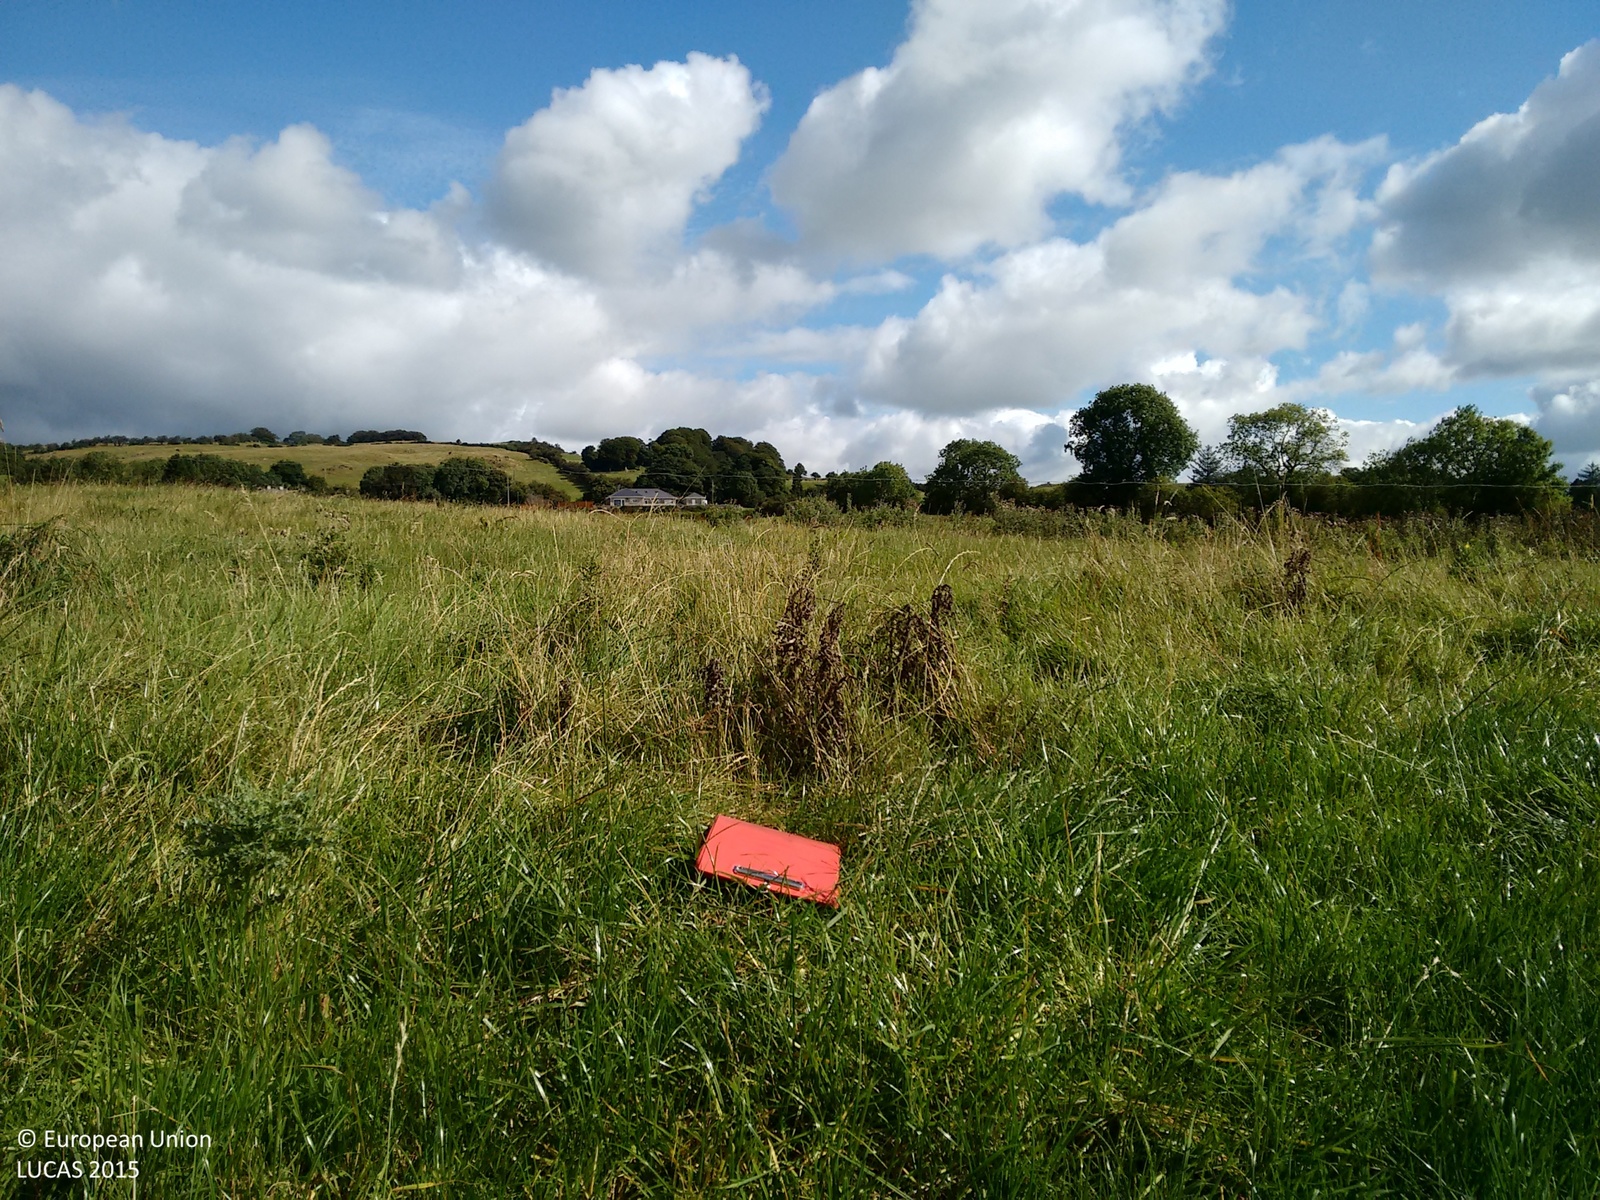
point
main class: Grassland
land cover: Grassland without tree/shrub cover
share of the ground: > 75 %
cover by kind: herbaceous plants 100 %
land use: Agriculture (excluding fallow land and kitchen gardens)
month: September
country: IE
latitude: 53.7400
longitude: -7.0790
